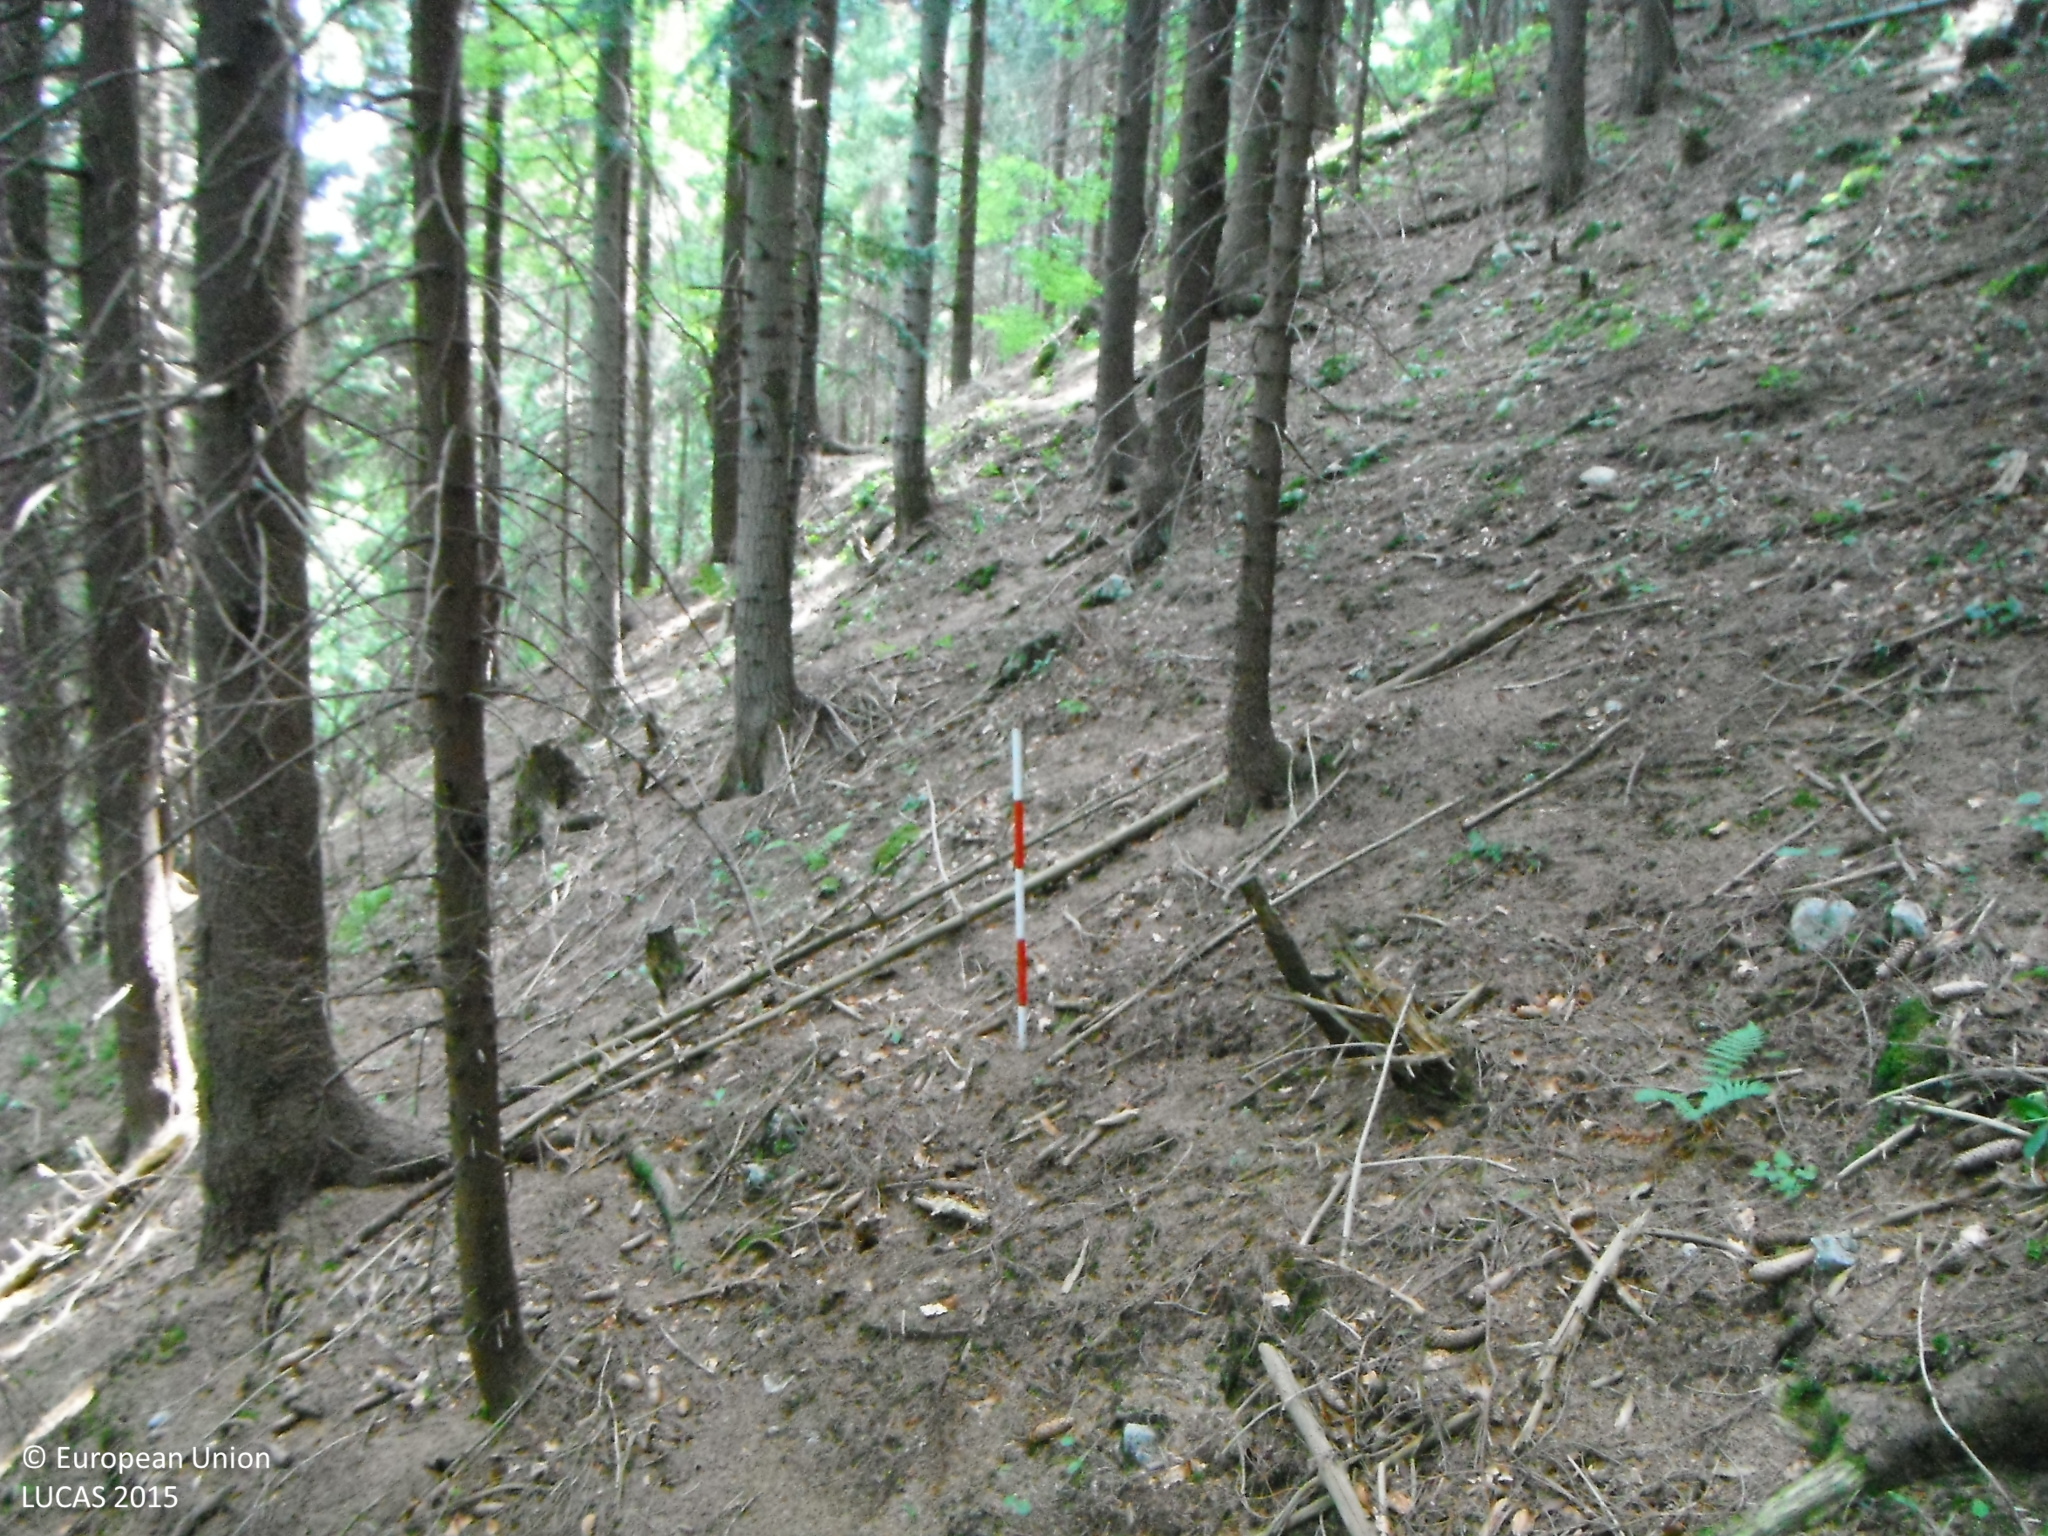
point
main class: Woodland
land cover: Spruce dominated coniferous woodland
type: alpine coniferous forest
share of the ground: > 75 %
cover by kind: coniferous forest trees 95 %, broadleaved forest trees 5 %
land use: Forestry
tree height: > 5 m
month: July
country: SK
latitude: 49.2560
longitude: 19.1324
